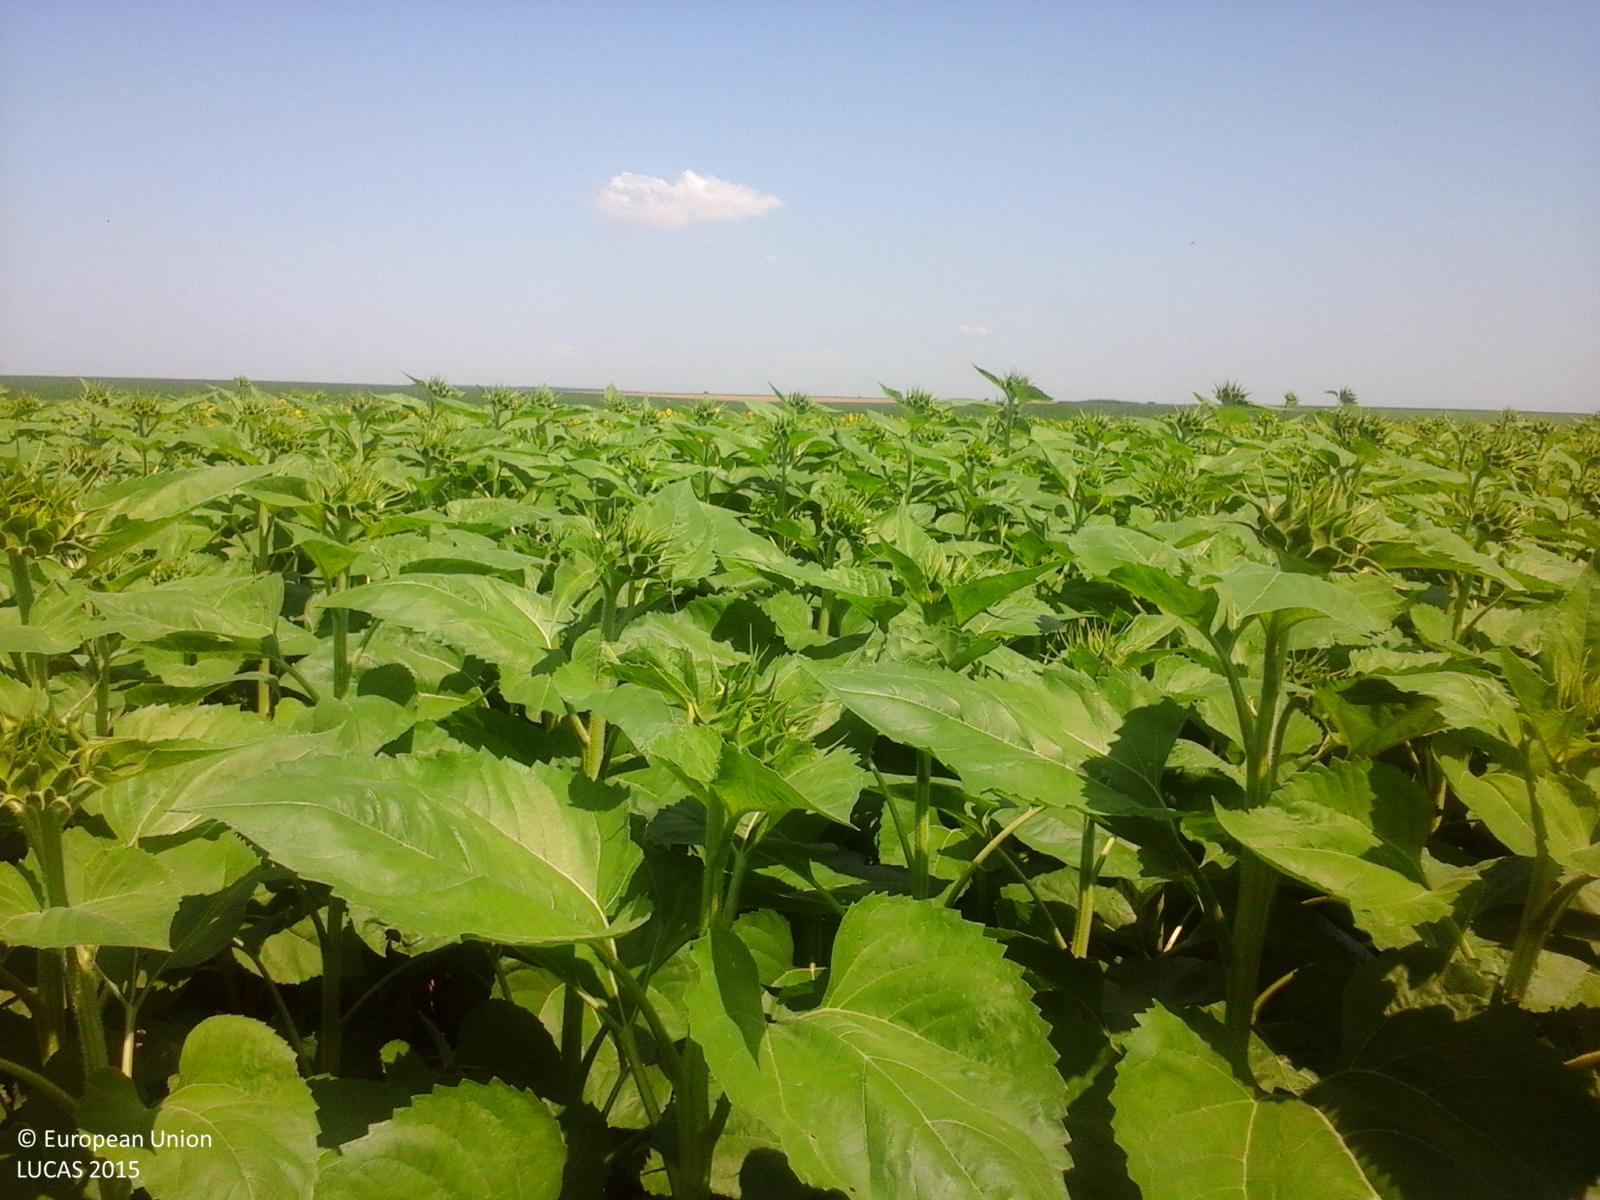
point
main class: Cropland
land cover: Sunflower
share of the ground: > 75 %
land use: Agriculture (excluding fallow land and kitchen gardens)
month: July
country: RO
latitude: 44.4905
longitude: 24.5456
